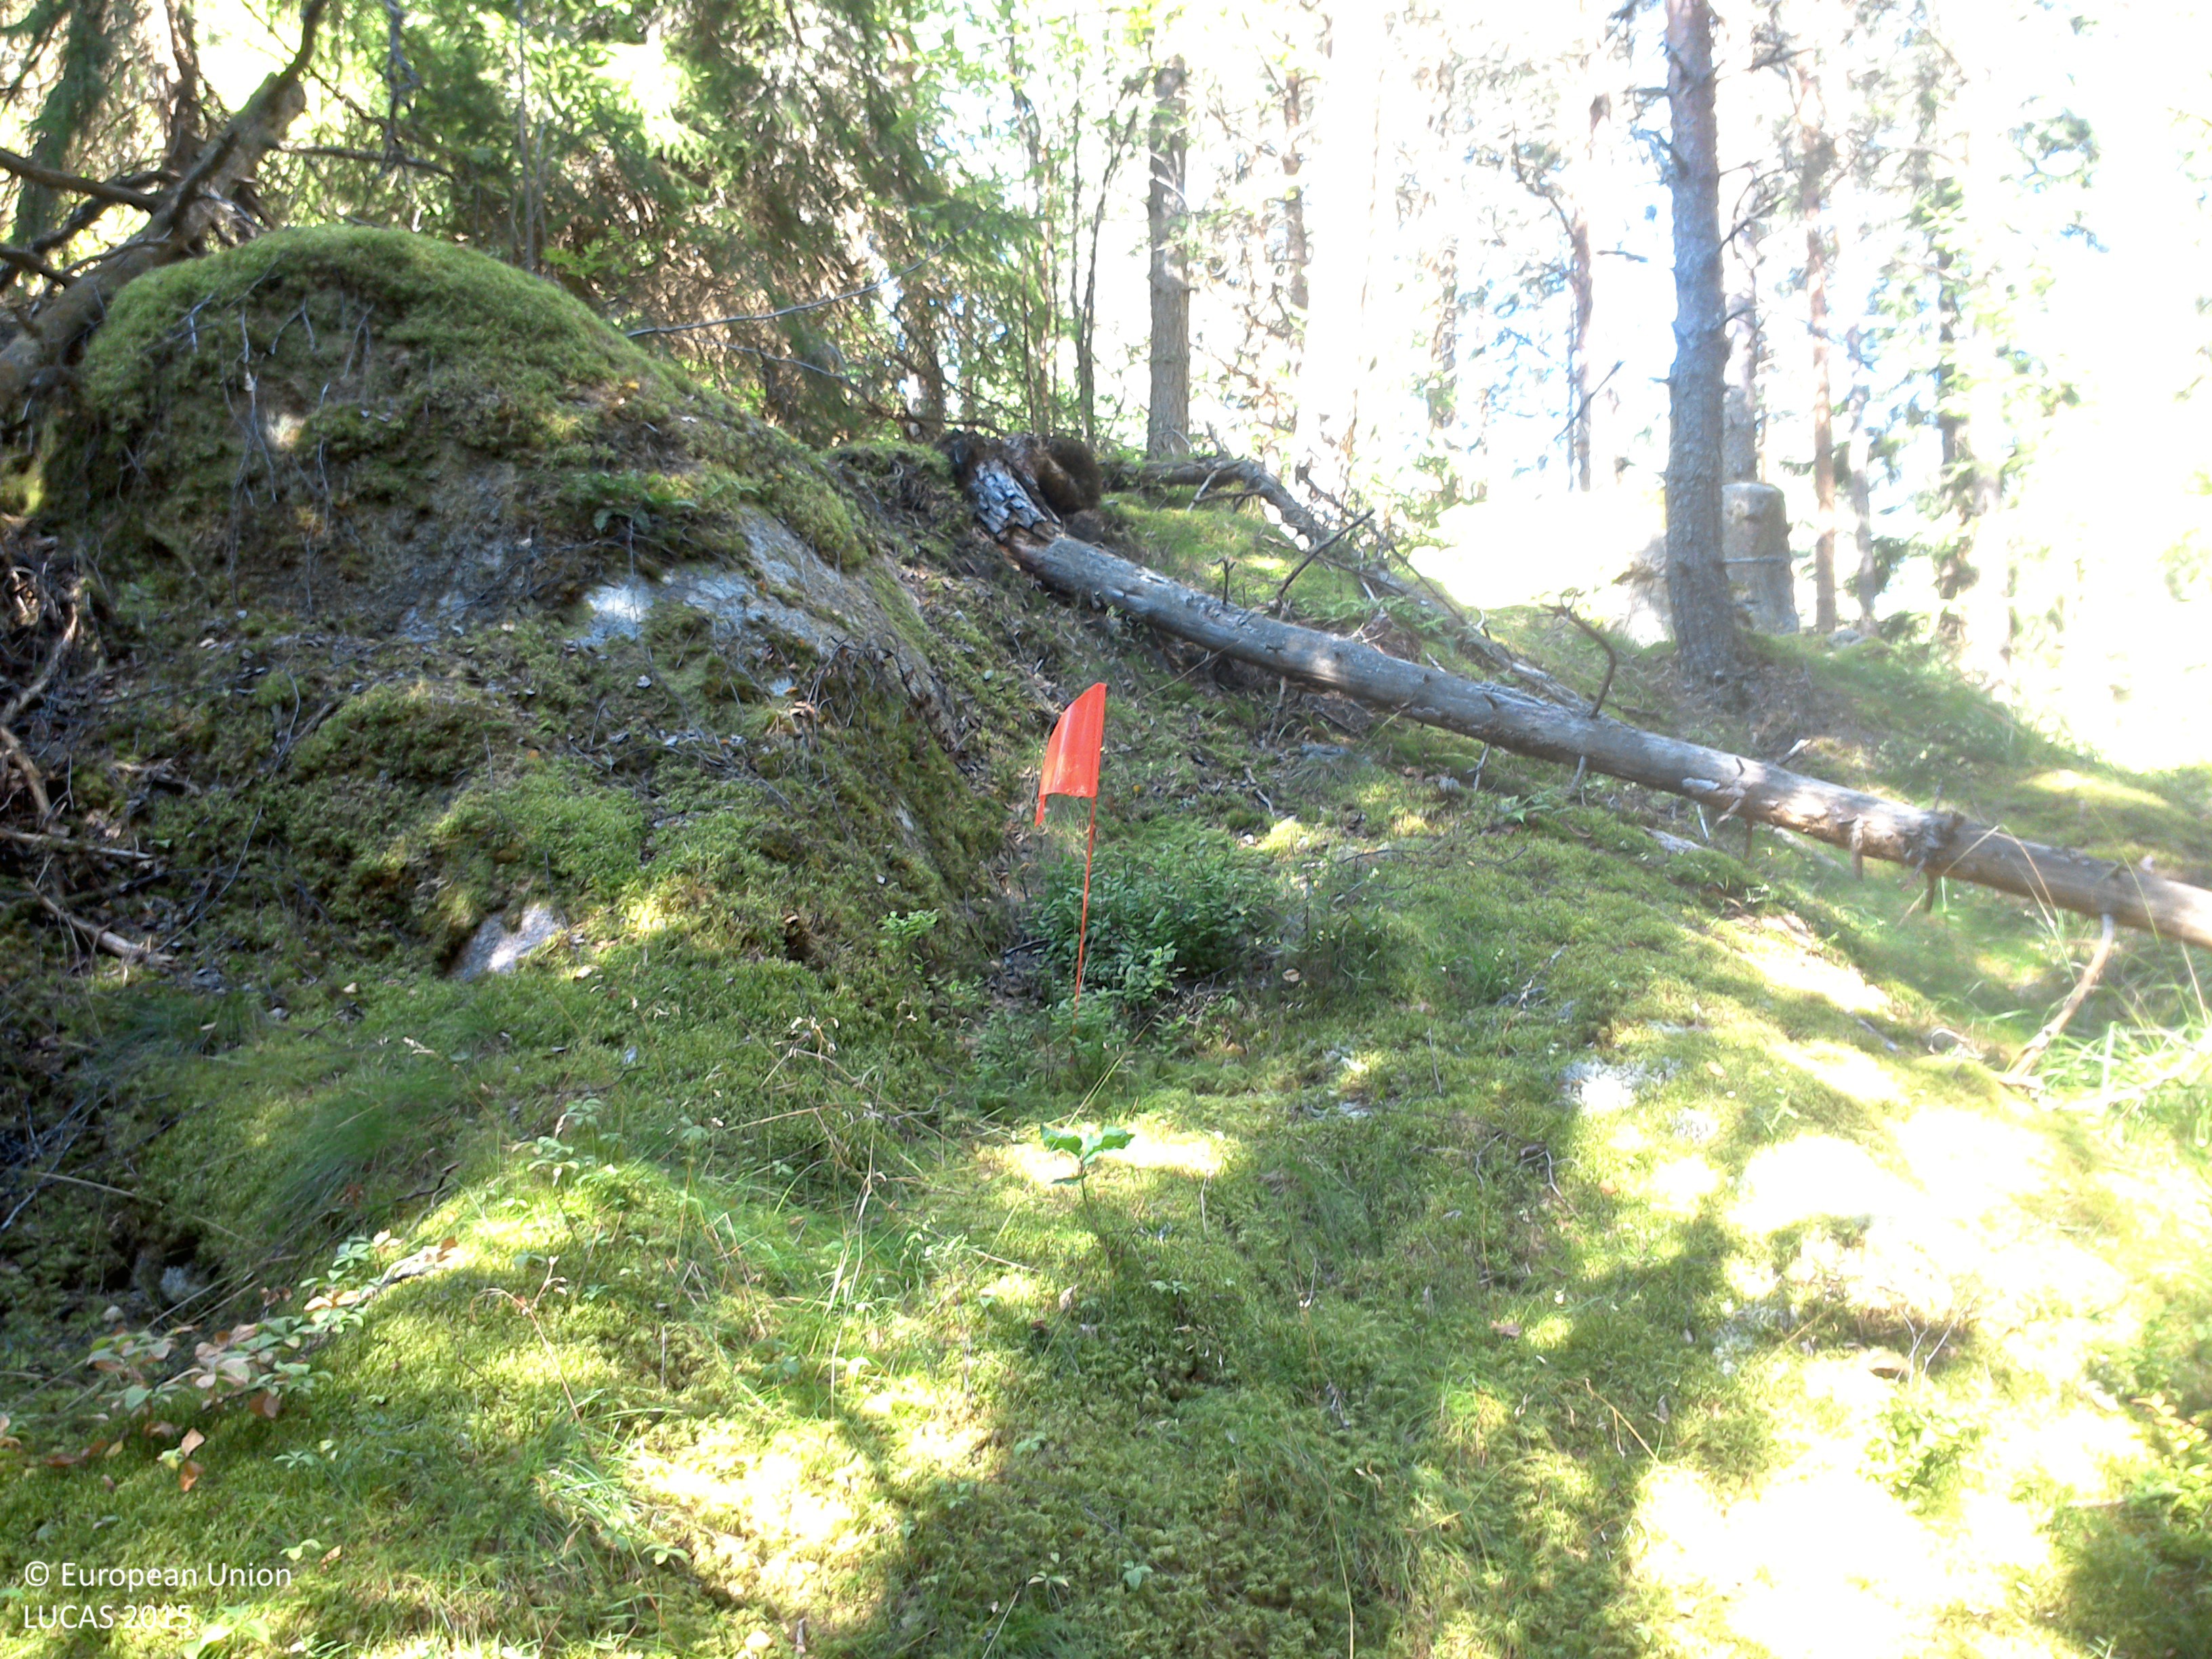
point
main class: Woodland
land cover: Pine dominated coniferous woodland
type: boreal forest
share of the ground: 25 - 50 %
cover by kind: coniferous forest trees 50 %, lichens and mosses 40 %, herbaceous plants 10 %
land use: Forestry
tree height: > 5 m
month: August
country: SE
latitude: 58.2148
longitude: 15.0498
